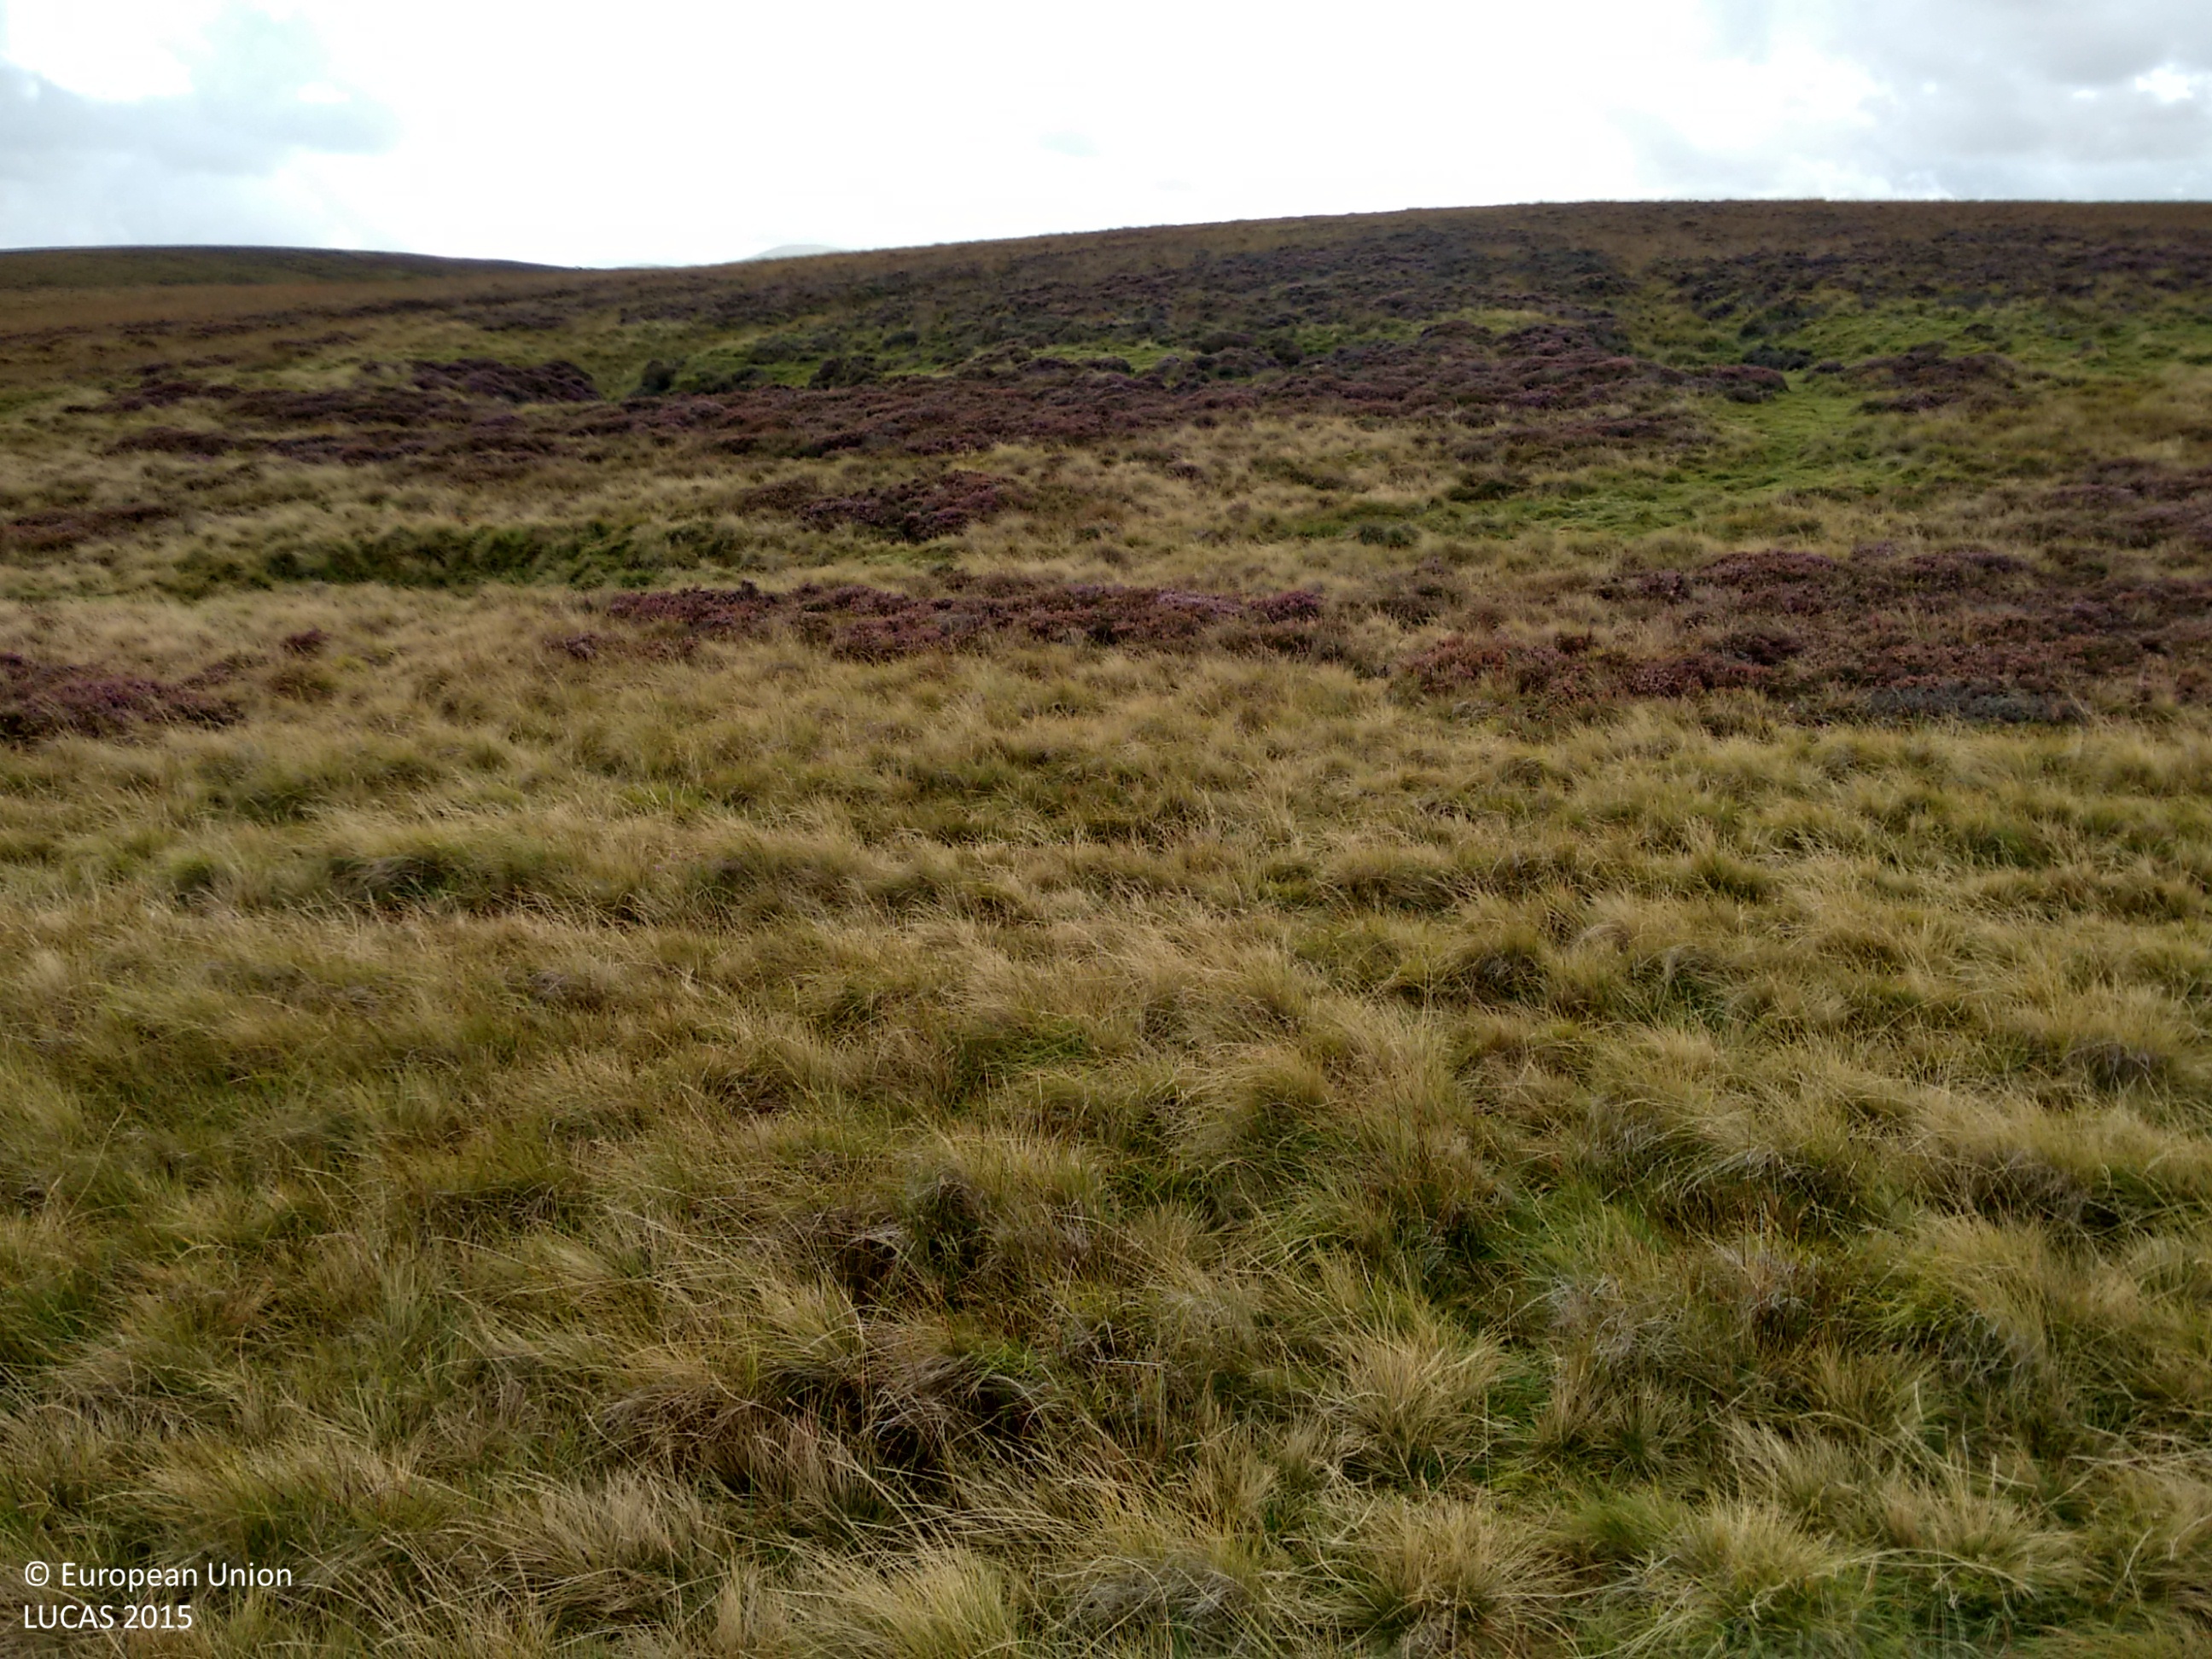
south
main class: Grassland
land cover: Grassland without tree/shrub cover
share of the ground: > 75 %
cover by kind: herbaceous plants 100 %
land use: Agriculture (excluding fallow land and kitchen gardens)
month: September
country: GB
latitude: 54.4642
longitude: -2.4830
